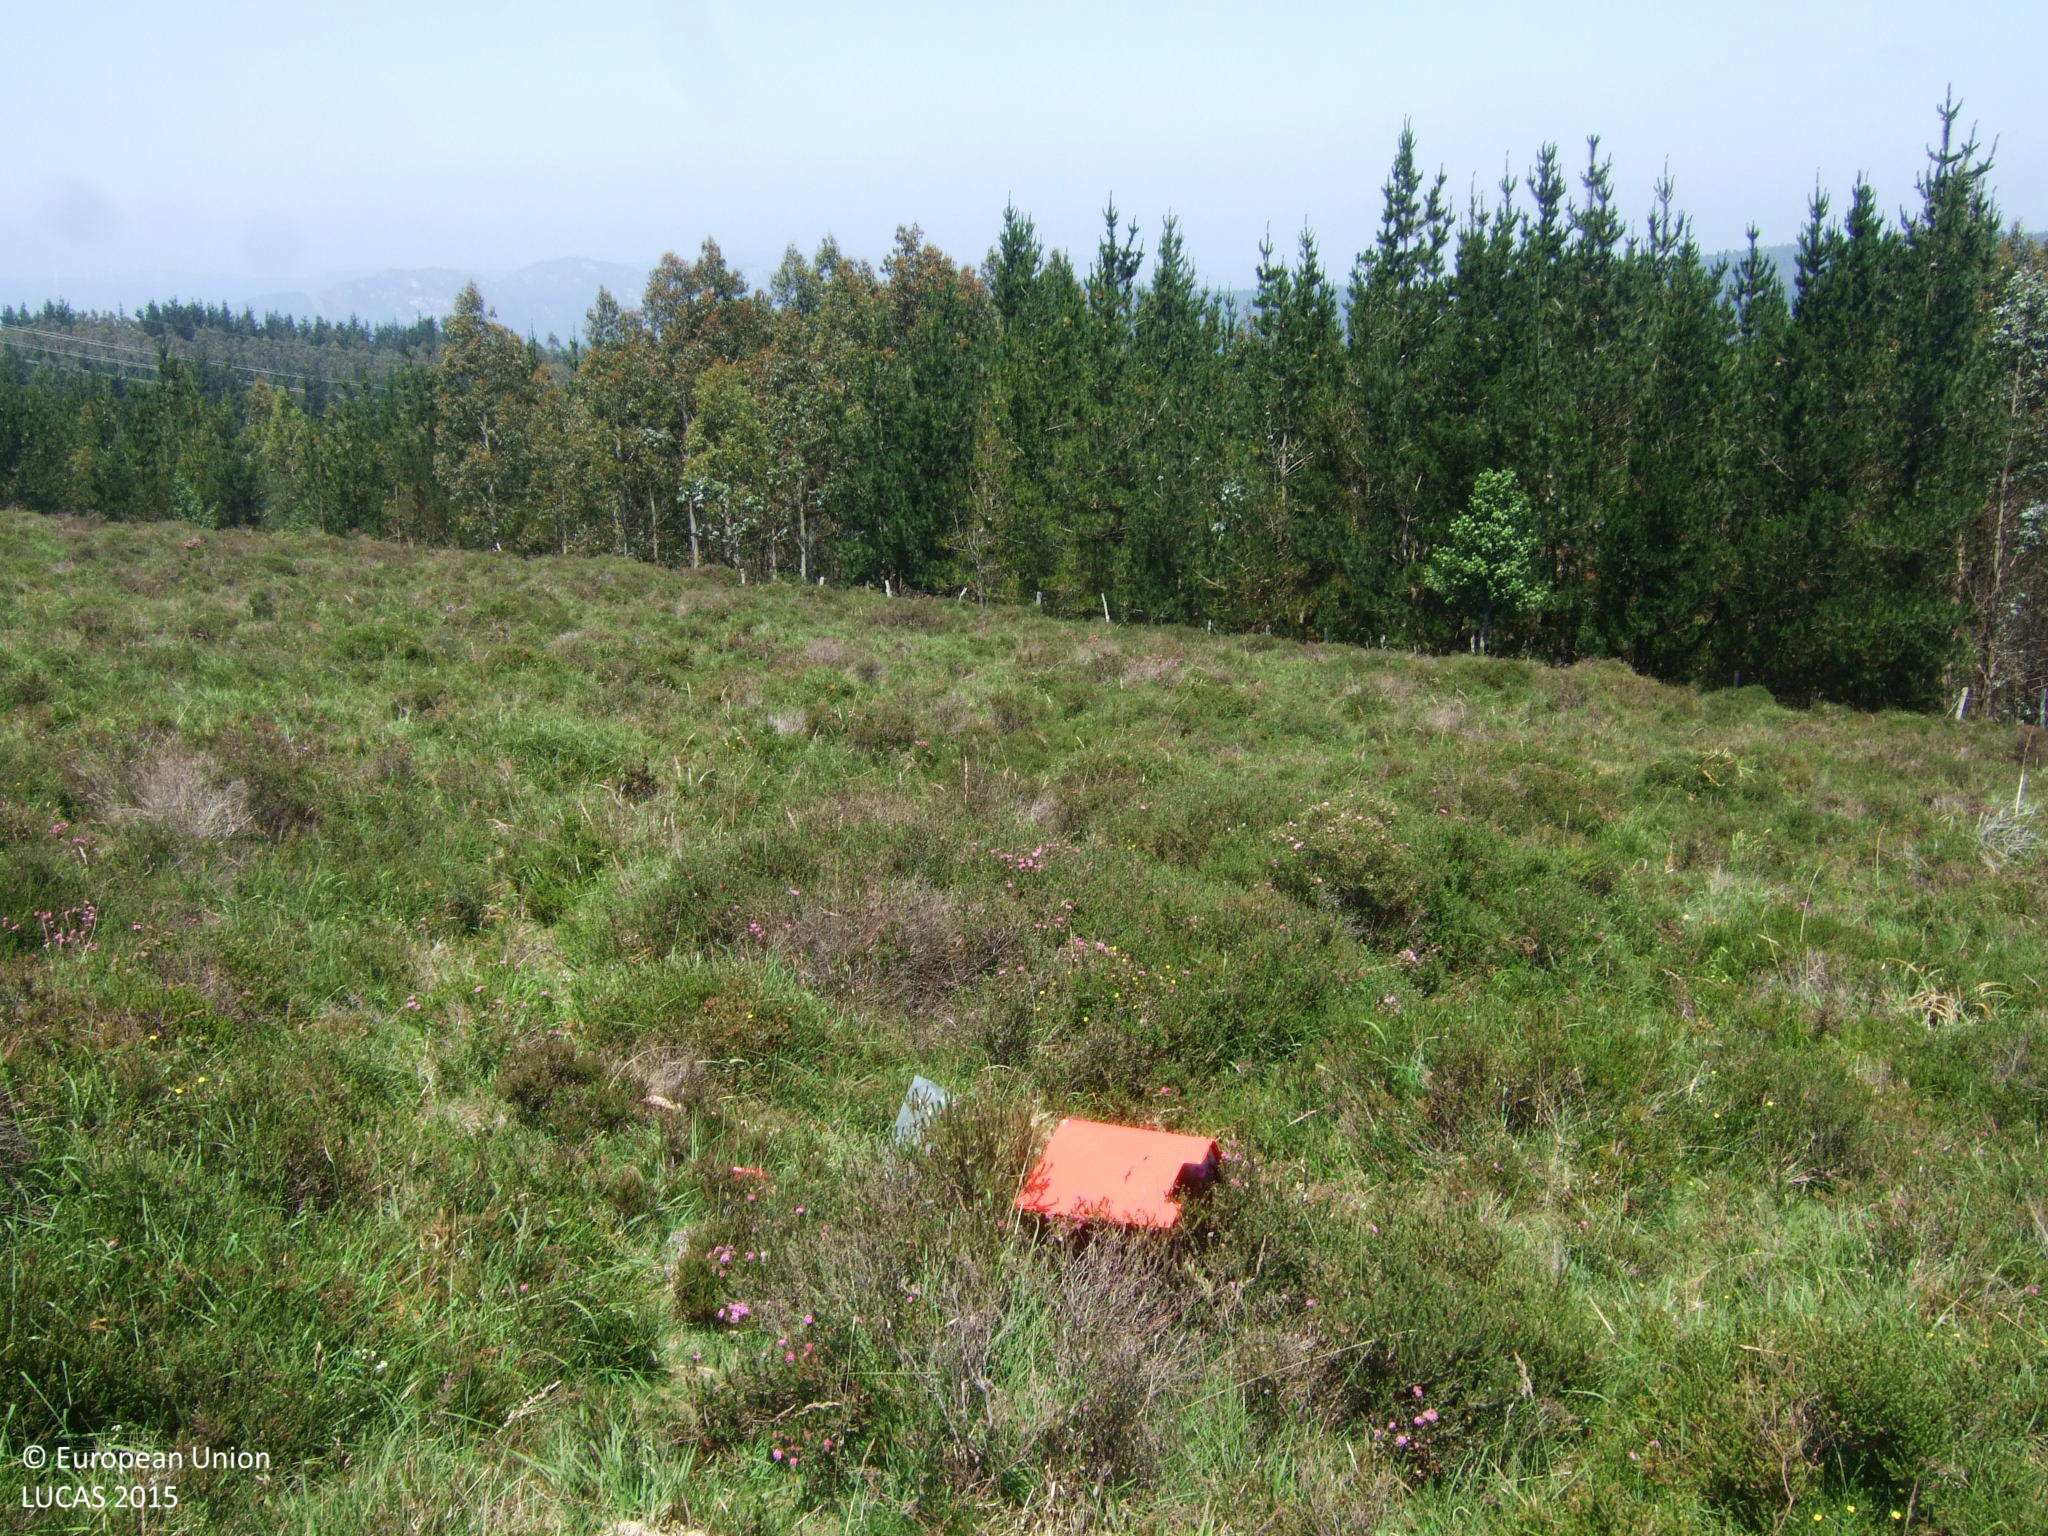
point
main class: Shrubland
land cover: Shrubland without tree cover
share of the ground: > 75 %
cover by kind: shrubs 90 %, herbaceous plants 10 %
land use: Agriculture (excluding fallow land and kitchen gardens)
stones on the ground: 10 - 25 %
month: June
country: ES
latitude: 43.5589
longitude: -7.5512
